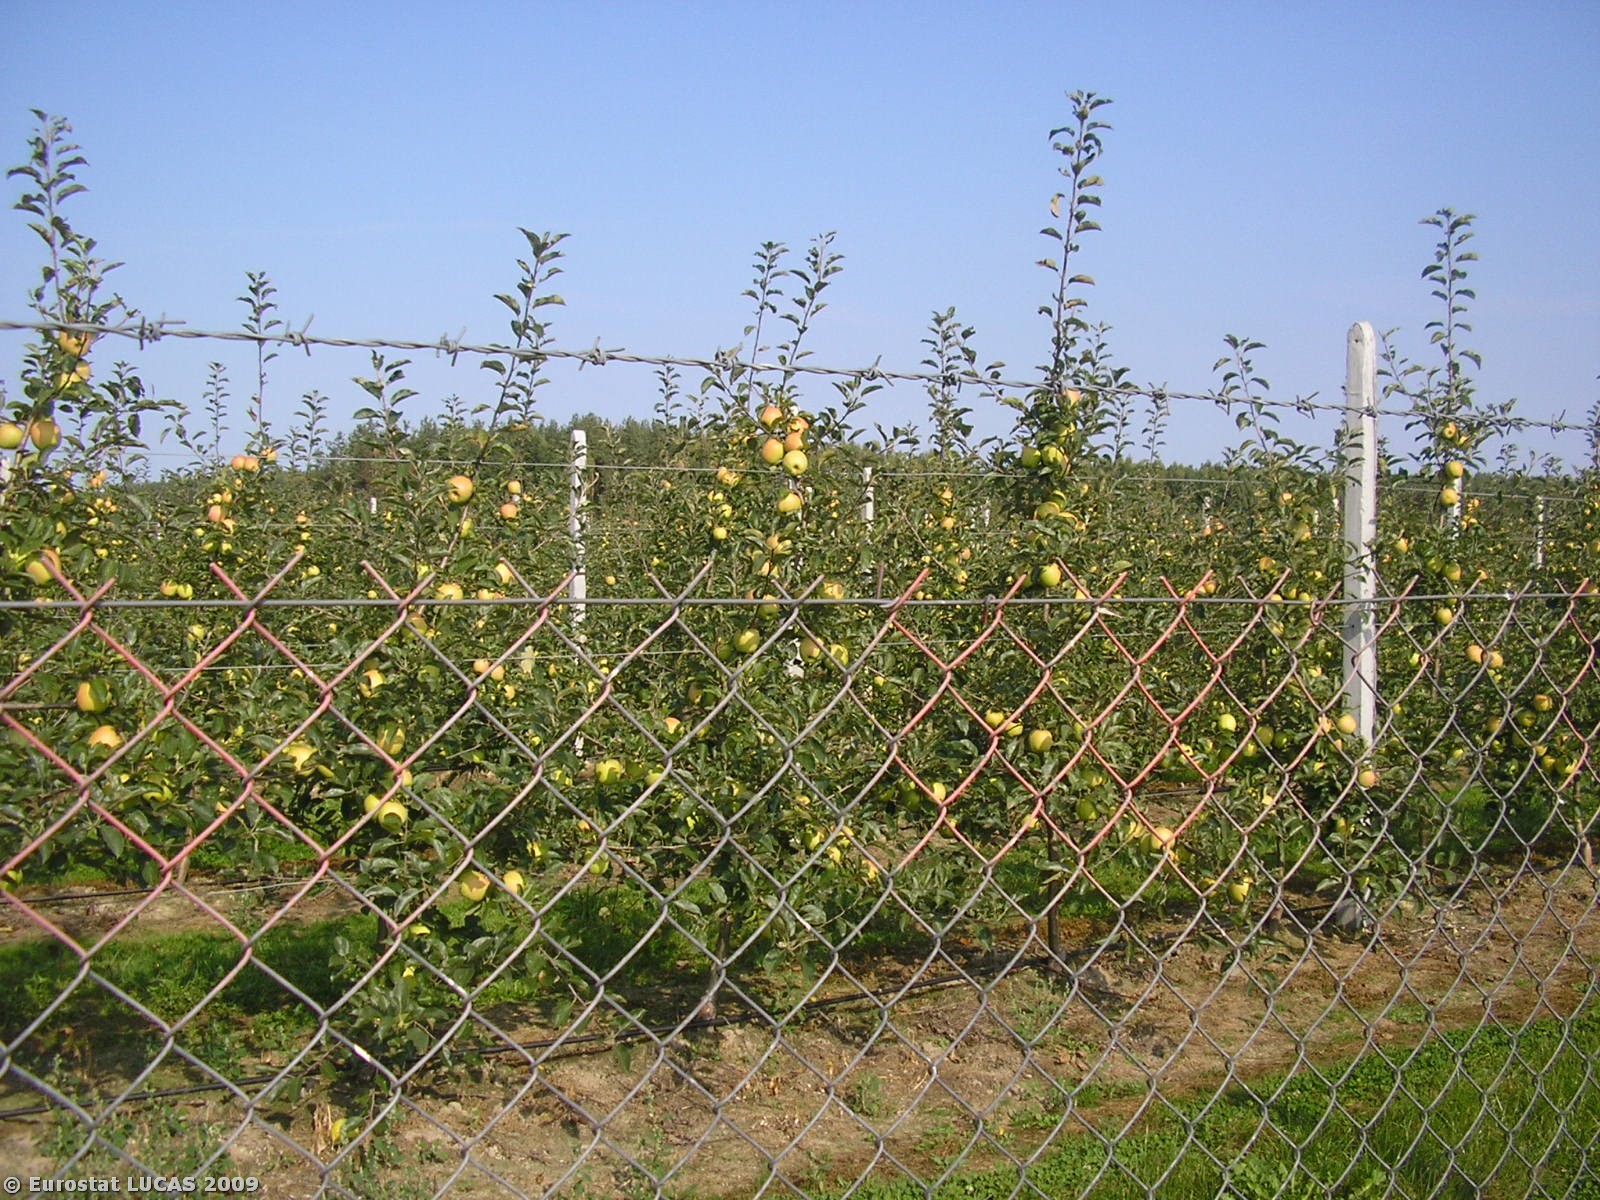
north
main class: Cropland
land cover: Apple fruit
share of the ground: 25 - 50 %
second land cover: Grassland with sparse tree/shrub cover
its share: > 75 %
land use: Agriculture (excluding fallow land and kitchen gardens)
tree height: < 5 m
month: September
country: PL
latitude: 51.9286
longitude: 20.7005
